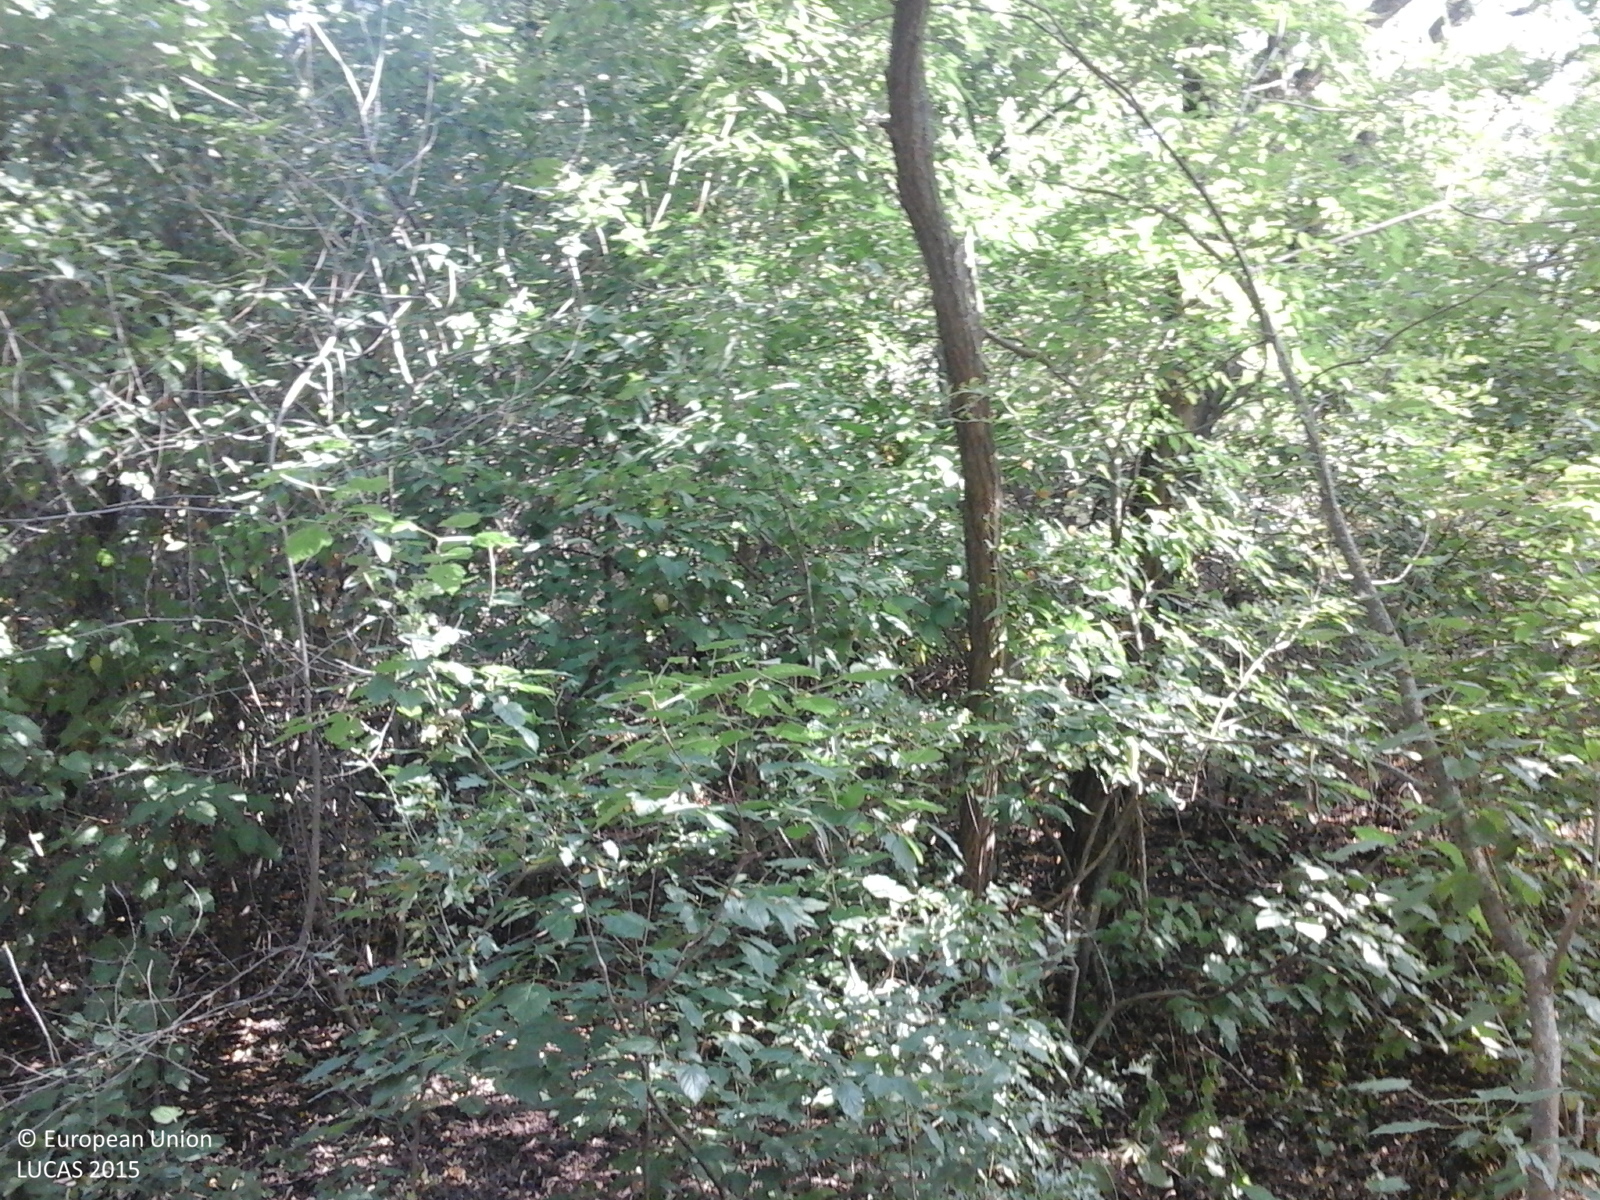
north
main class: Woodland
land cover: Broadleaved woodland
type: mesophytic deciduous forest
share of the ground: > 75 %
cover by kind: broadleaved forest trees 80 %, shrubs 10 %, herbaceous plants 10 %
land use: Forestry
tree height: > 5 m
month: July
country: RO
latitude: 46.1517
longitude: 27.5769
